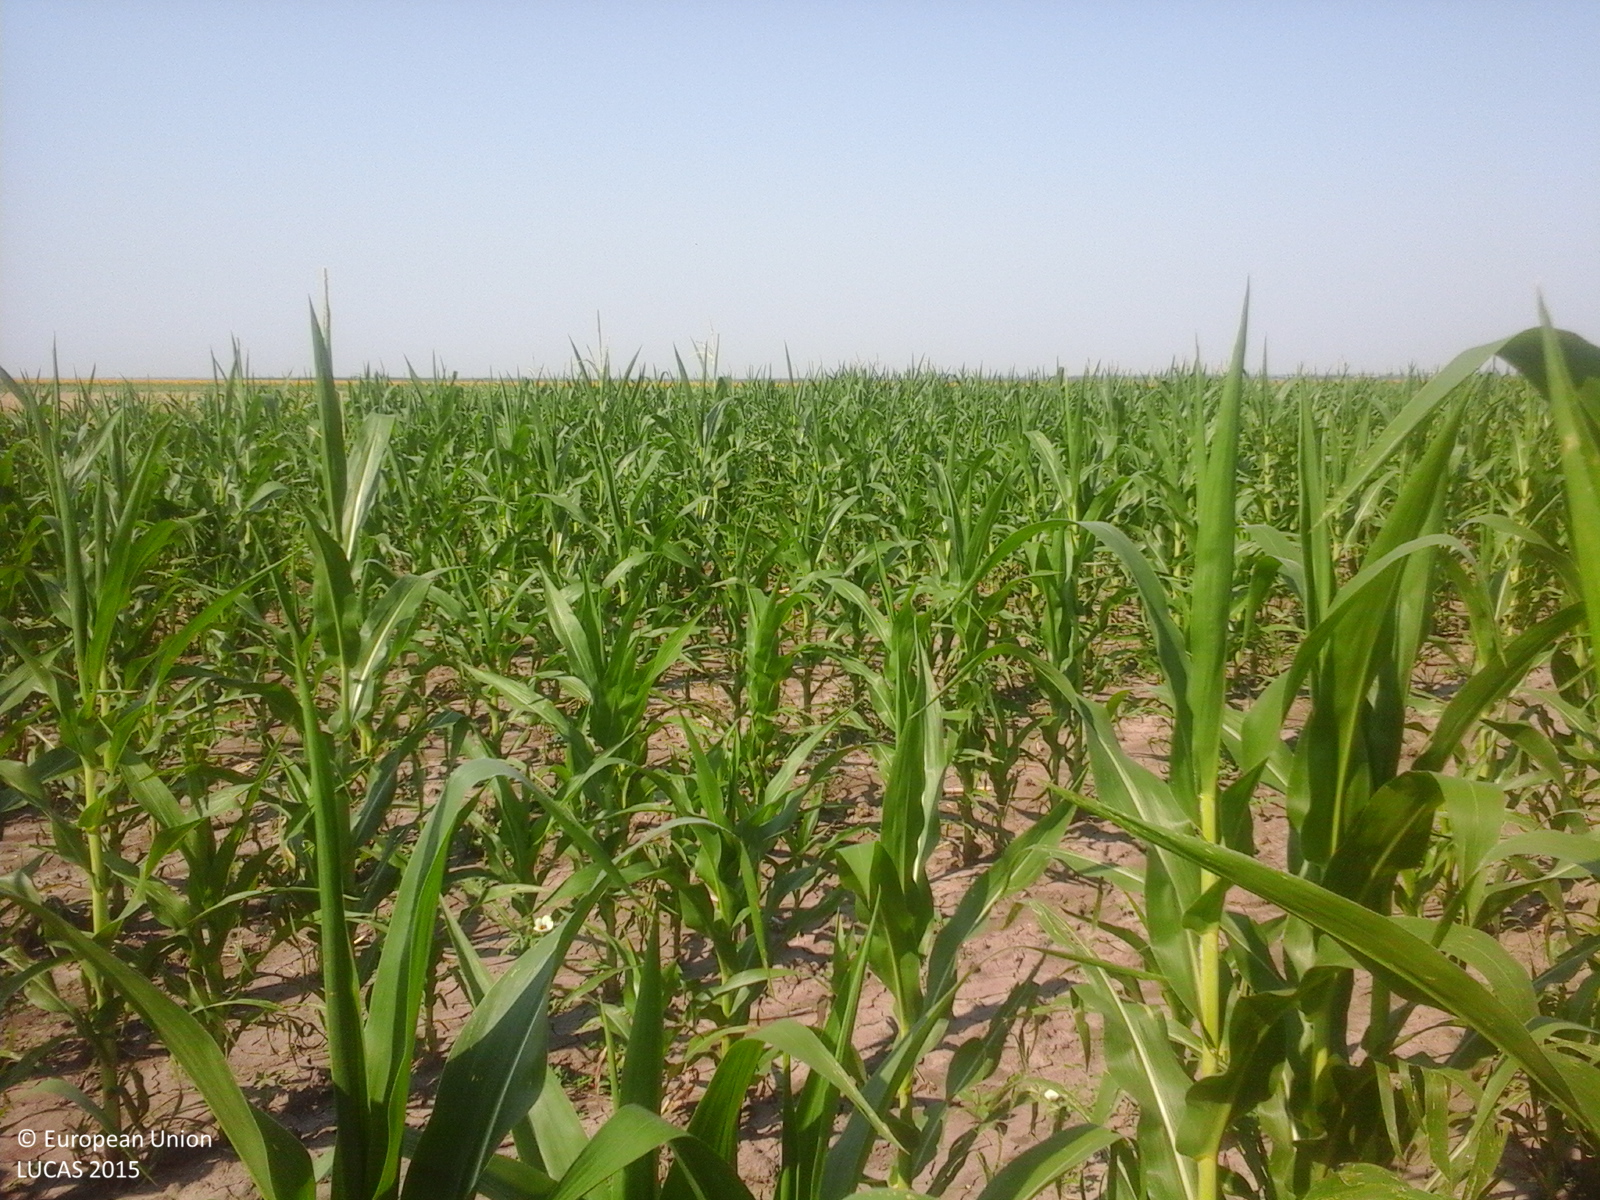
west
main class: Cropland
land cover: Maize
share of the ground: > 75 %
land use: Agriculture (excluding fallow land and kitchen gardens)
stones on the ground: < 10 %
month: July
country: RO
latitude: 44.5046
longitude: 24.8316
